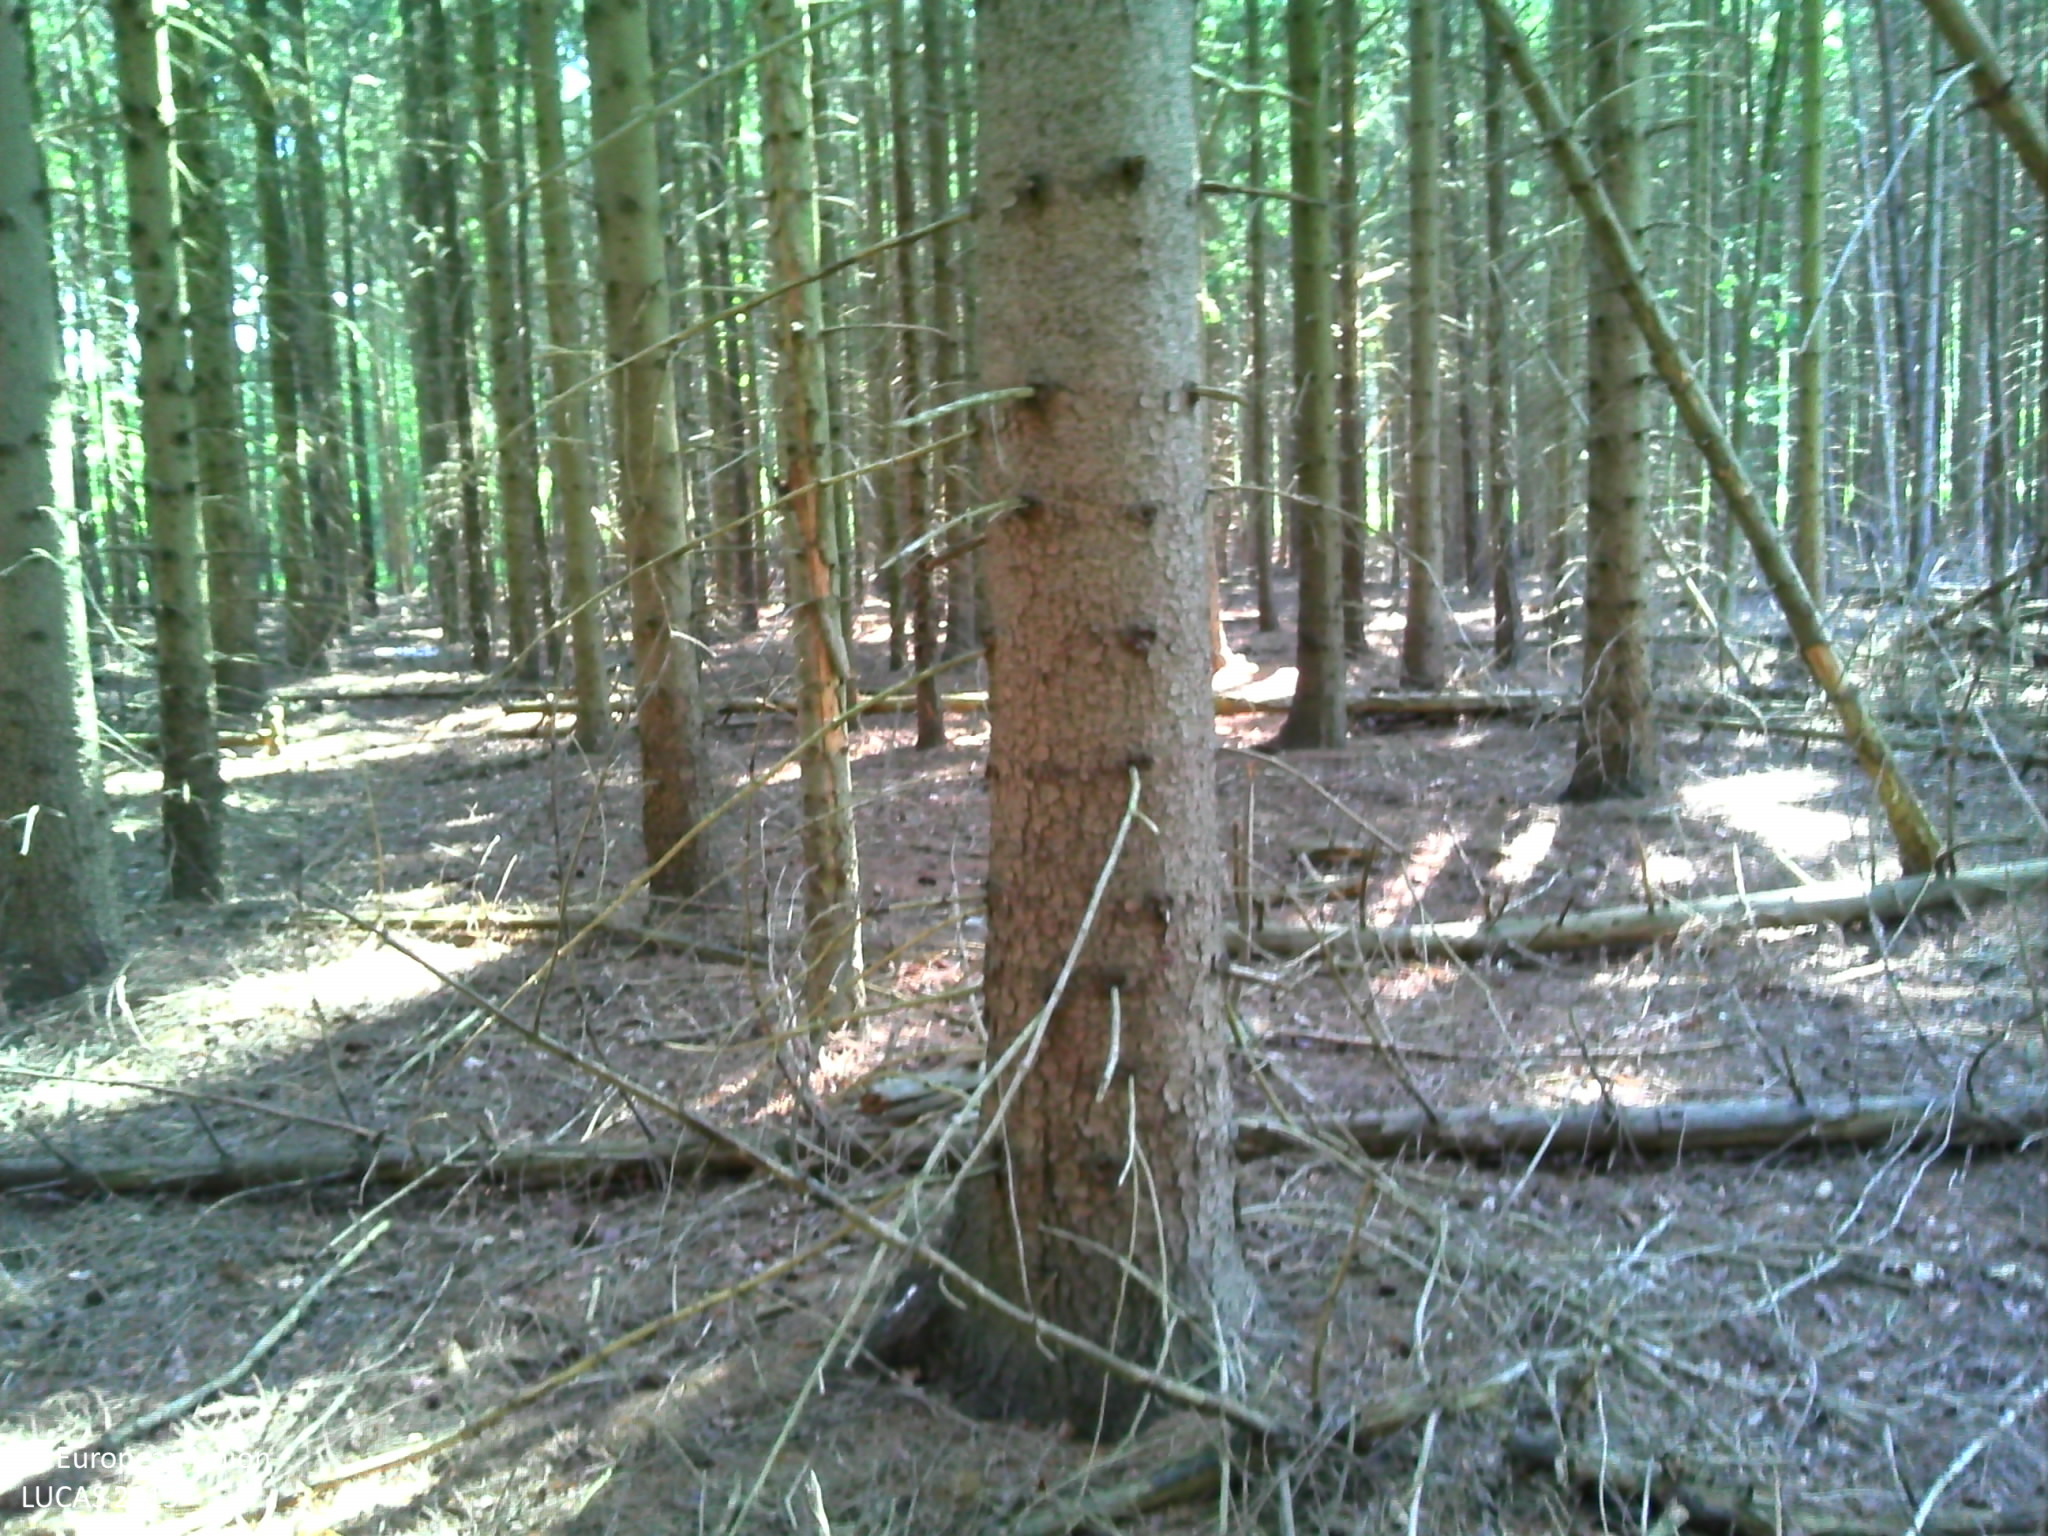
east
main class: Woodland
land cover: Pine dominated coniferous woodland
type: exotic forest
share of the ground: > 75 %
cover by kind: coniferous forest trees 90 %, unconsolidated bare surface 10 %
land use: Forestry
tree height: > 5 m
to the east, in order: Pine dominated coniferous woodland; Tracks; Pine dominated mixed woodland; Tracks; Pine dominated mixed woodland; Tracks; Broadleaved woodland
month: July
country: BE
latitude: 51.1509
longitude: 3.4586
